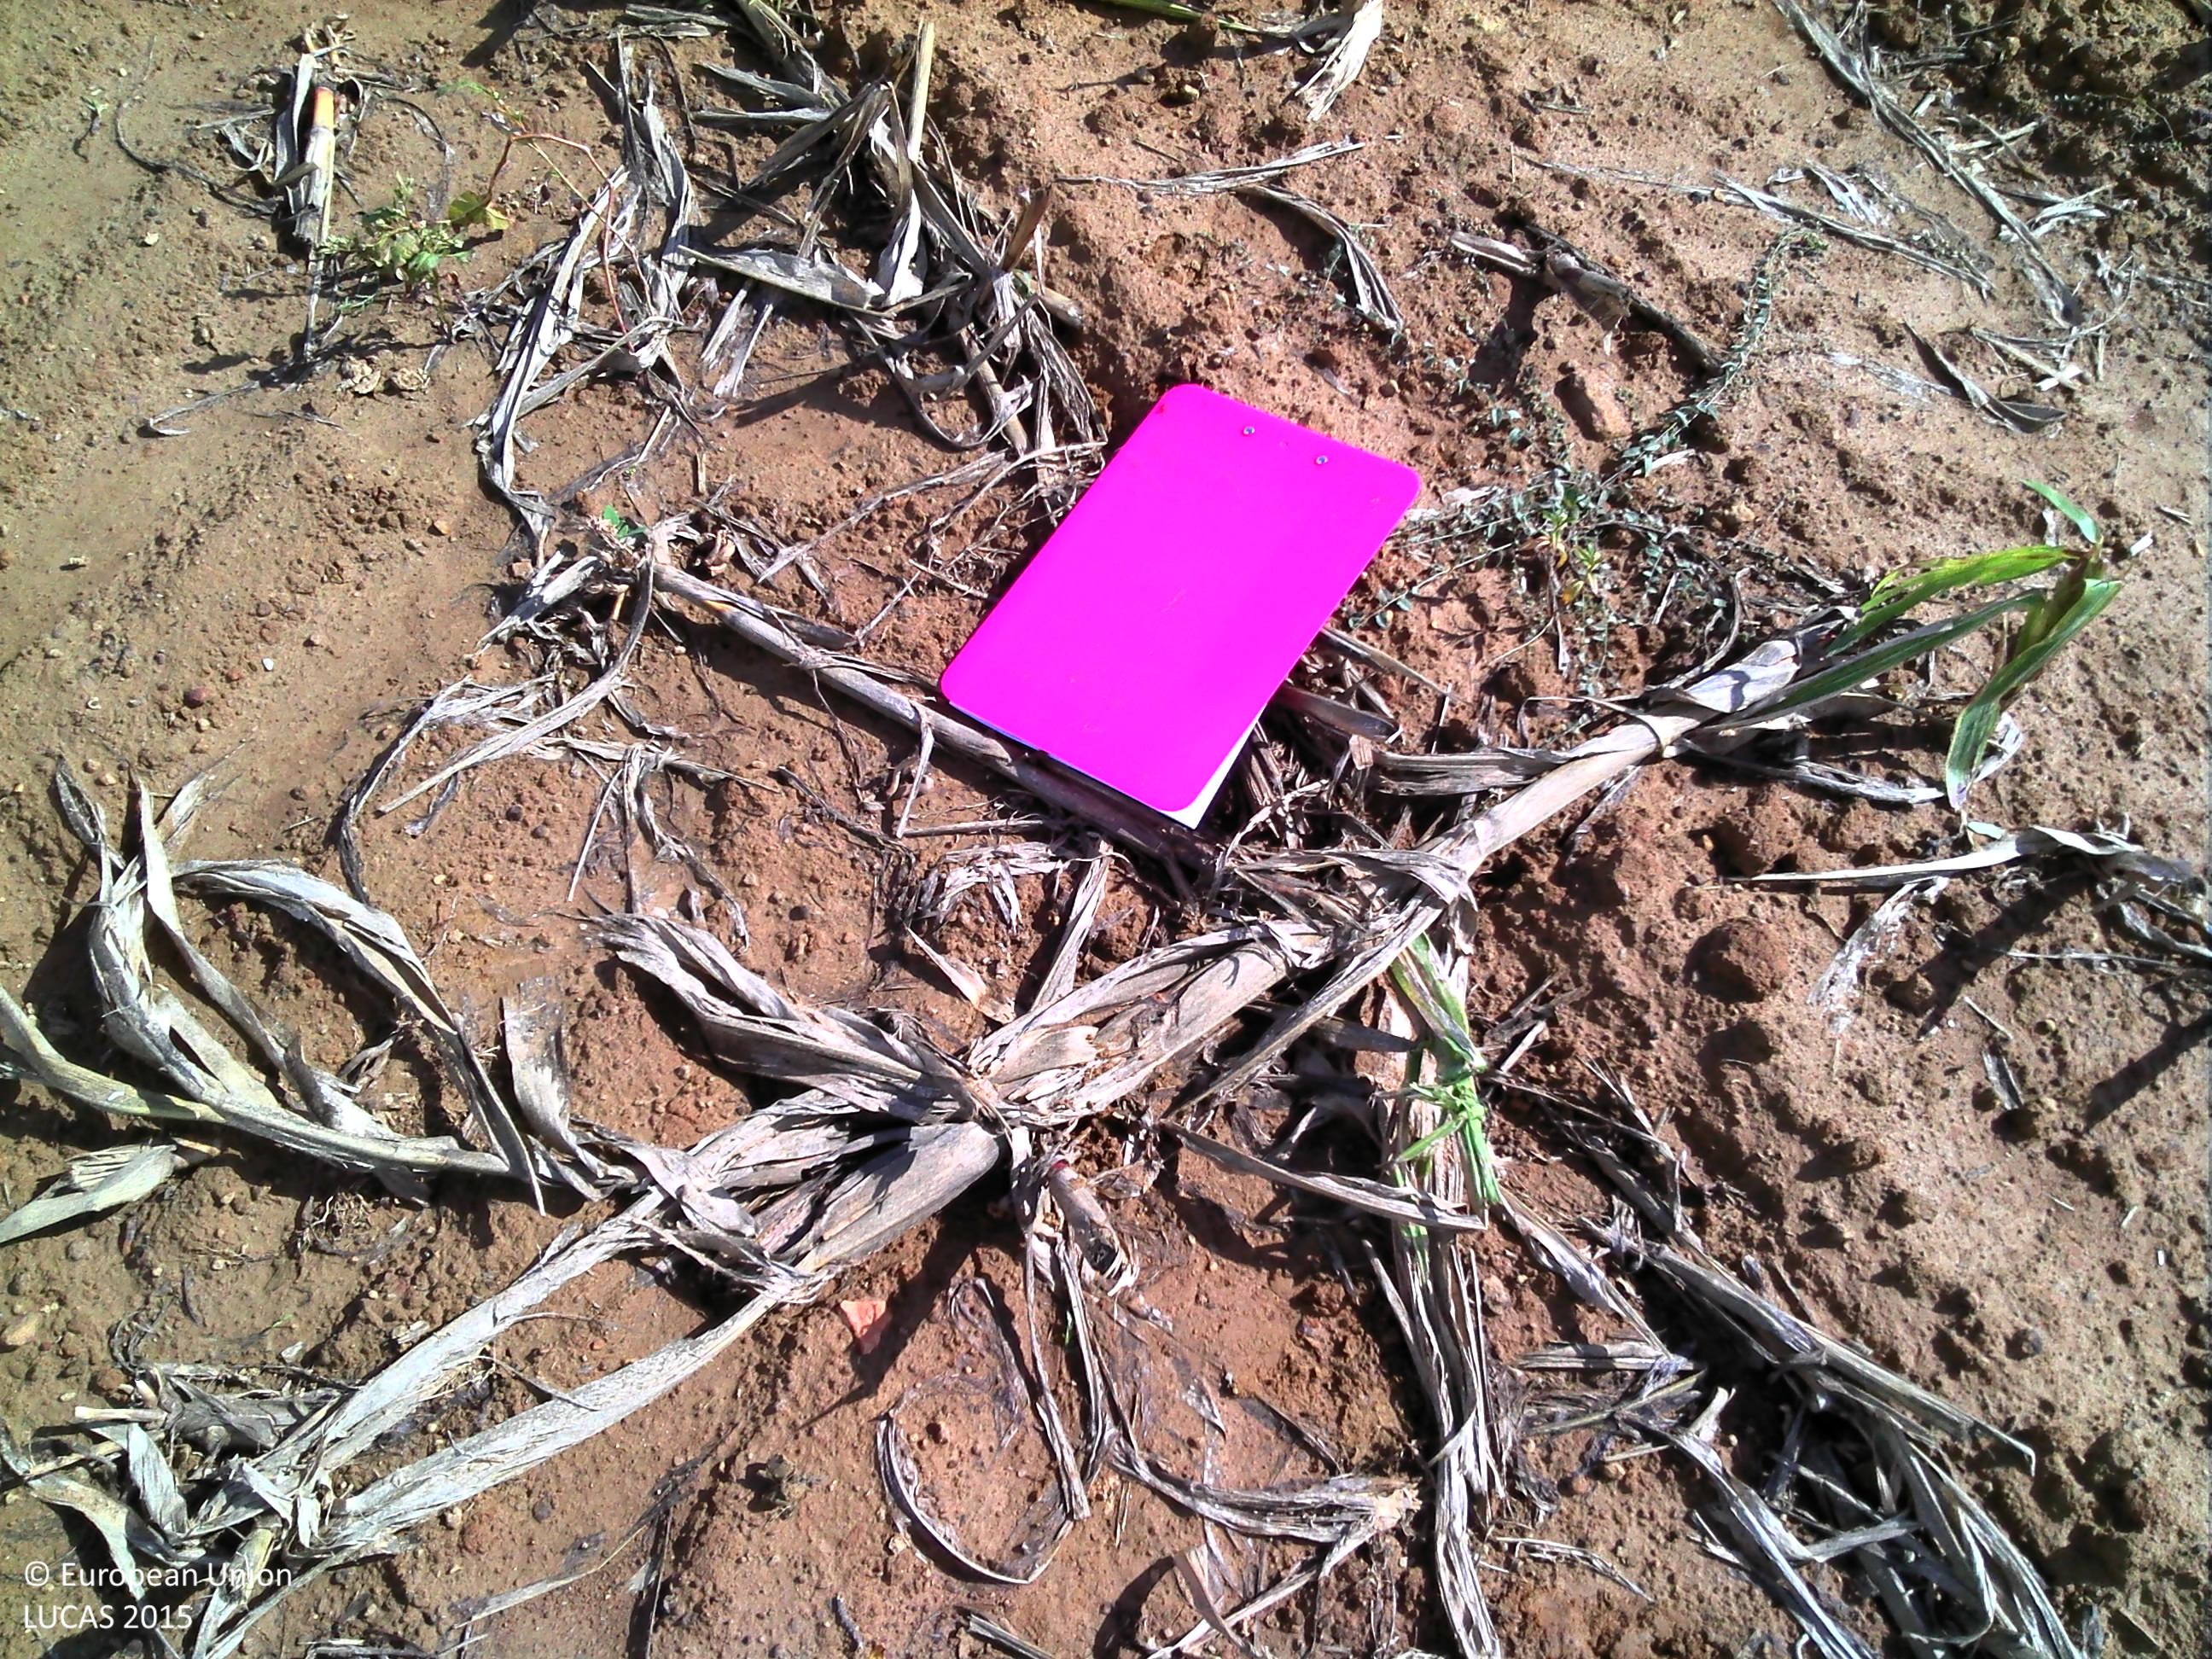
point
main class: Cropland
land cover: Maize
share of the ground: < 10 %
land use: Agriculture (excluding fallow land and kitchen gardens)
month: September
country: FR
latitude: 48.3675
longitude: 4.7200
